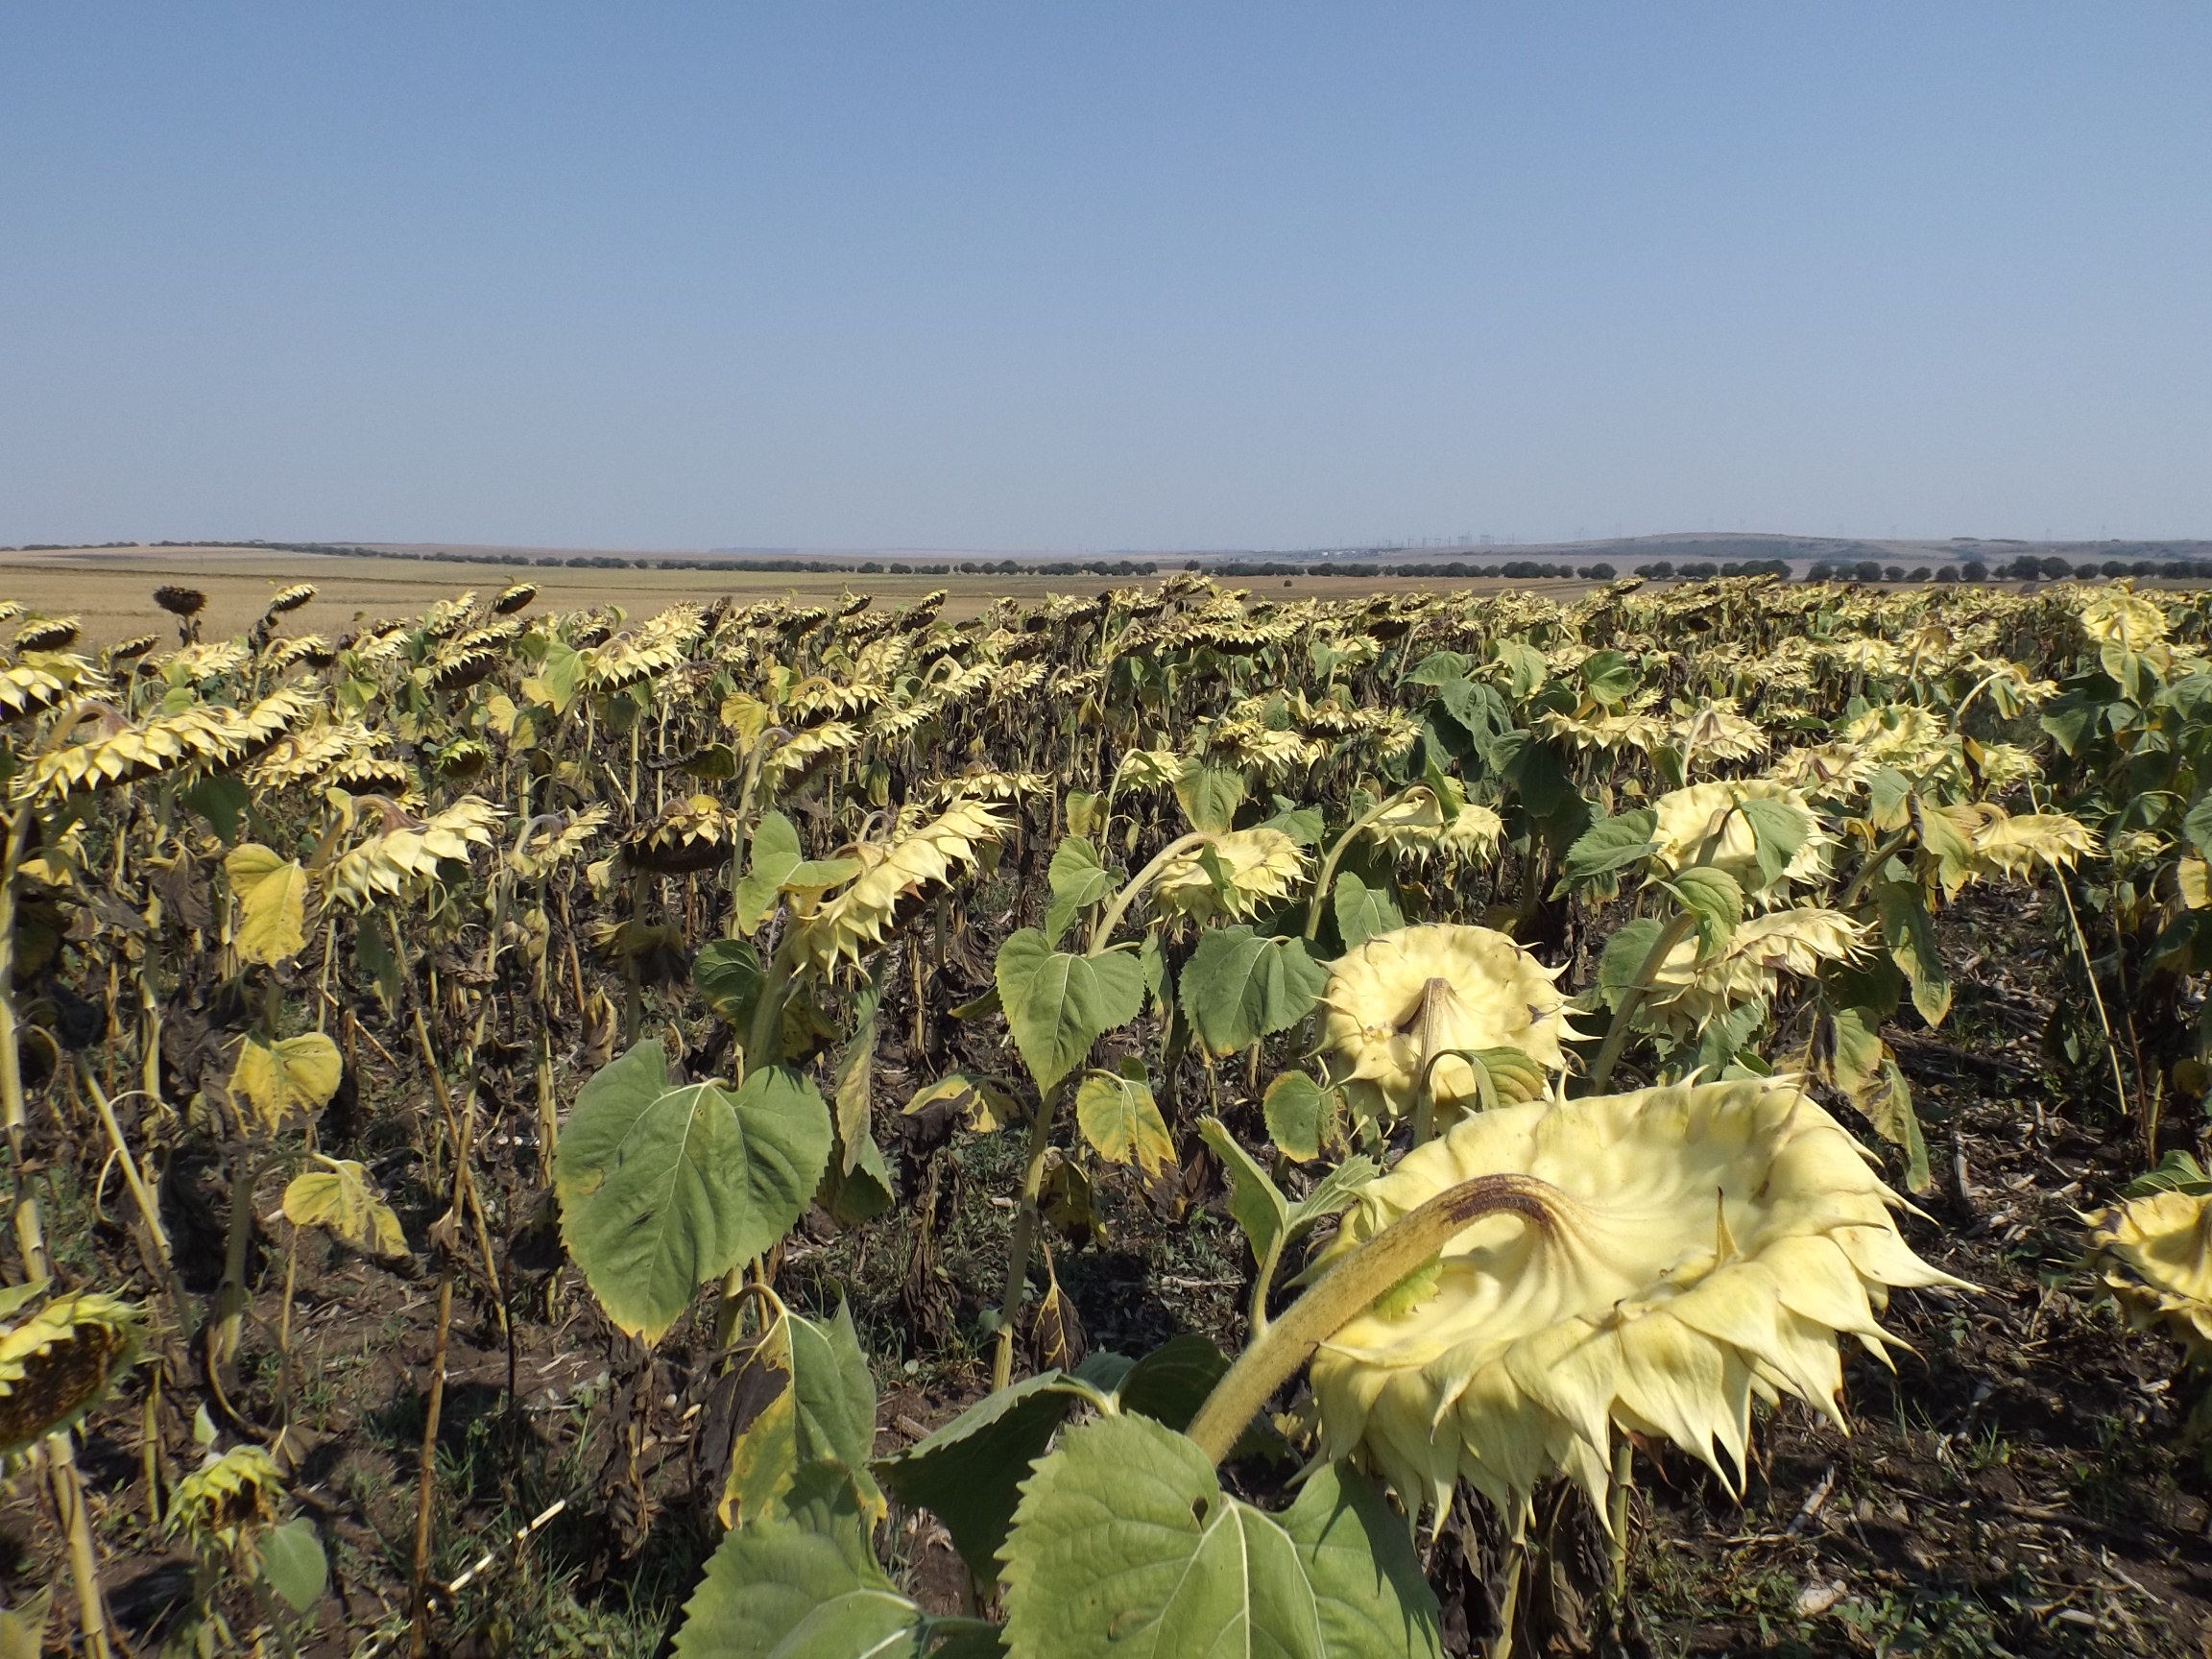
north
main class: Cropland
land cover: Sunflower
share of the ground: 50 - 75 %
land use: Agriculture (excluding fallow land and kitchen gardens)
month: August
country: BG
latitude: 43.2748
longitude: 27.4893
